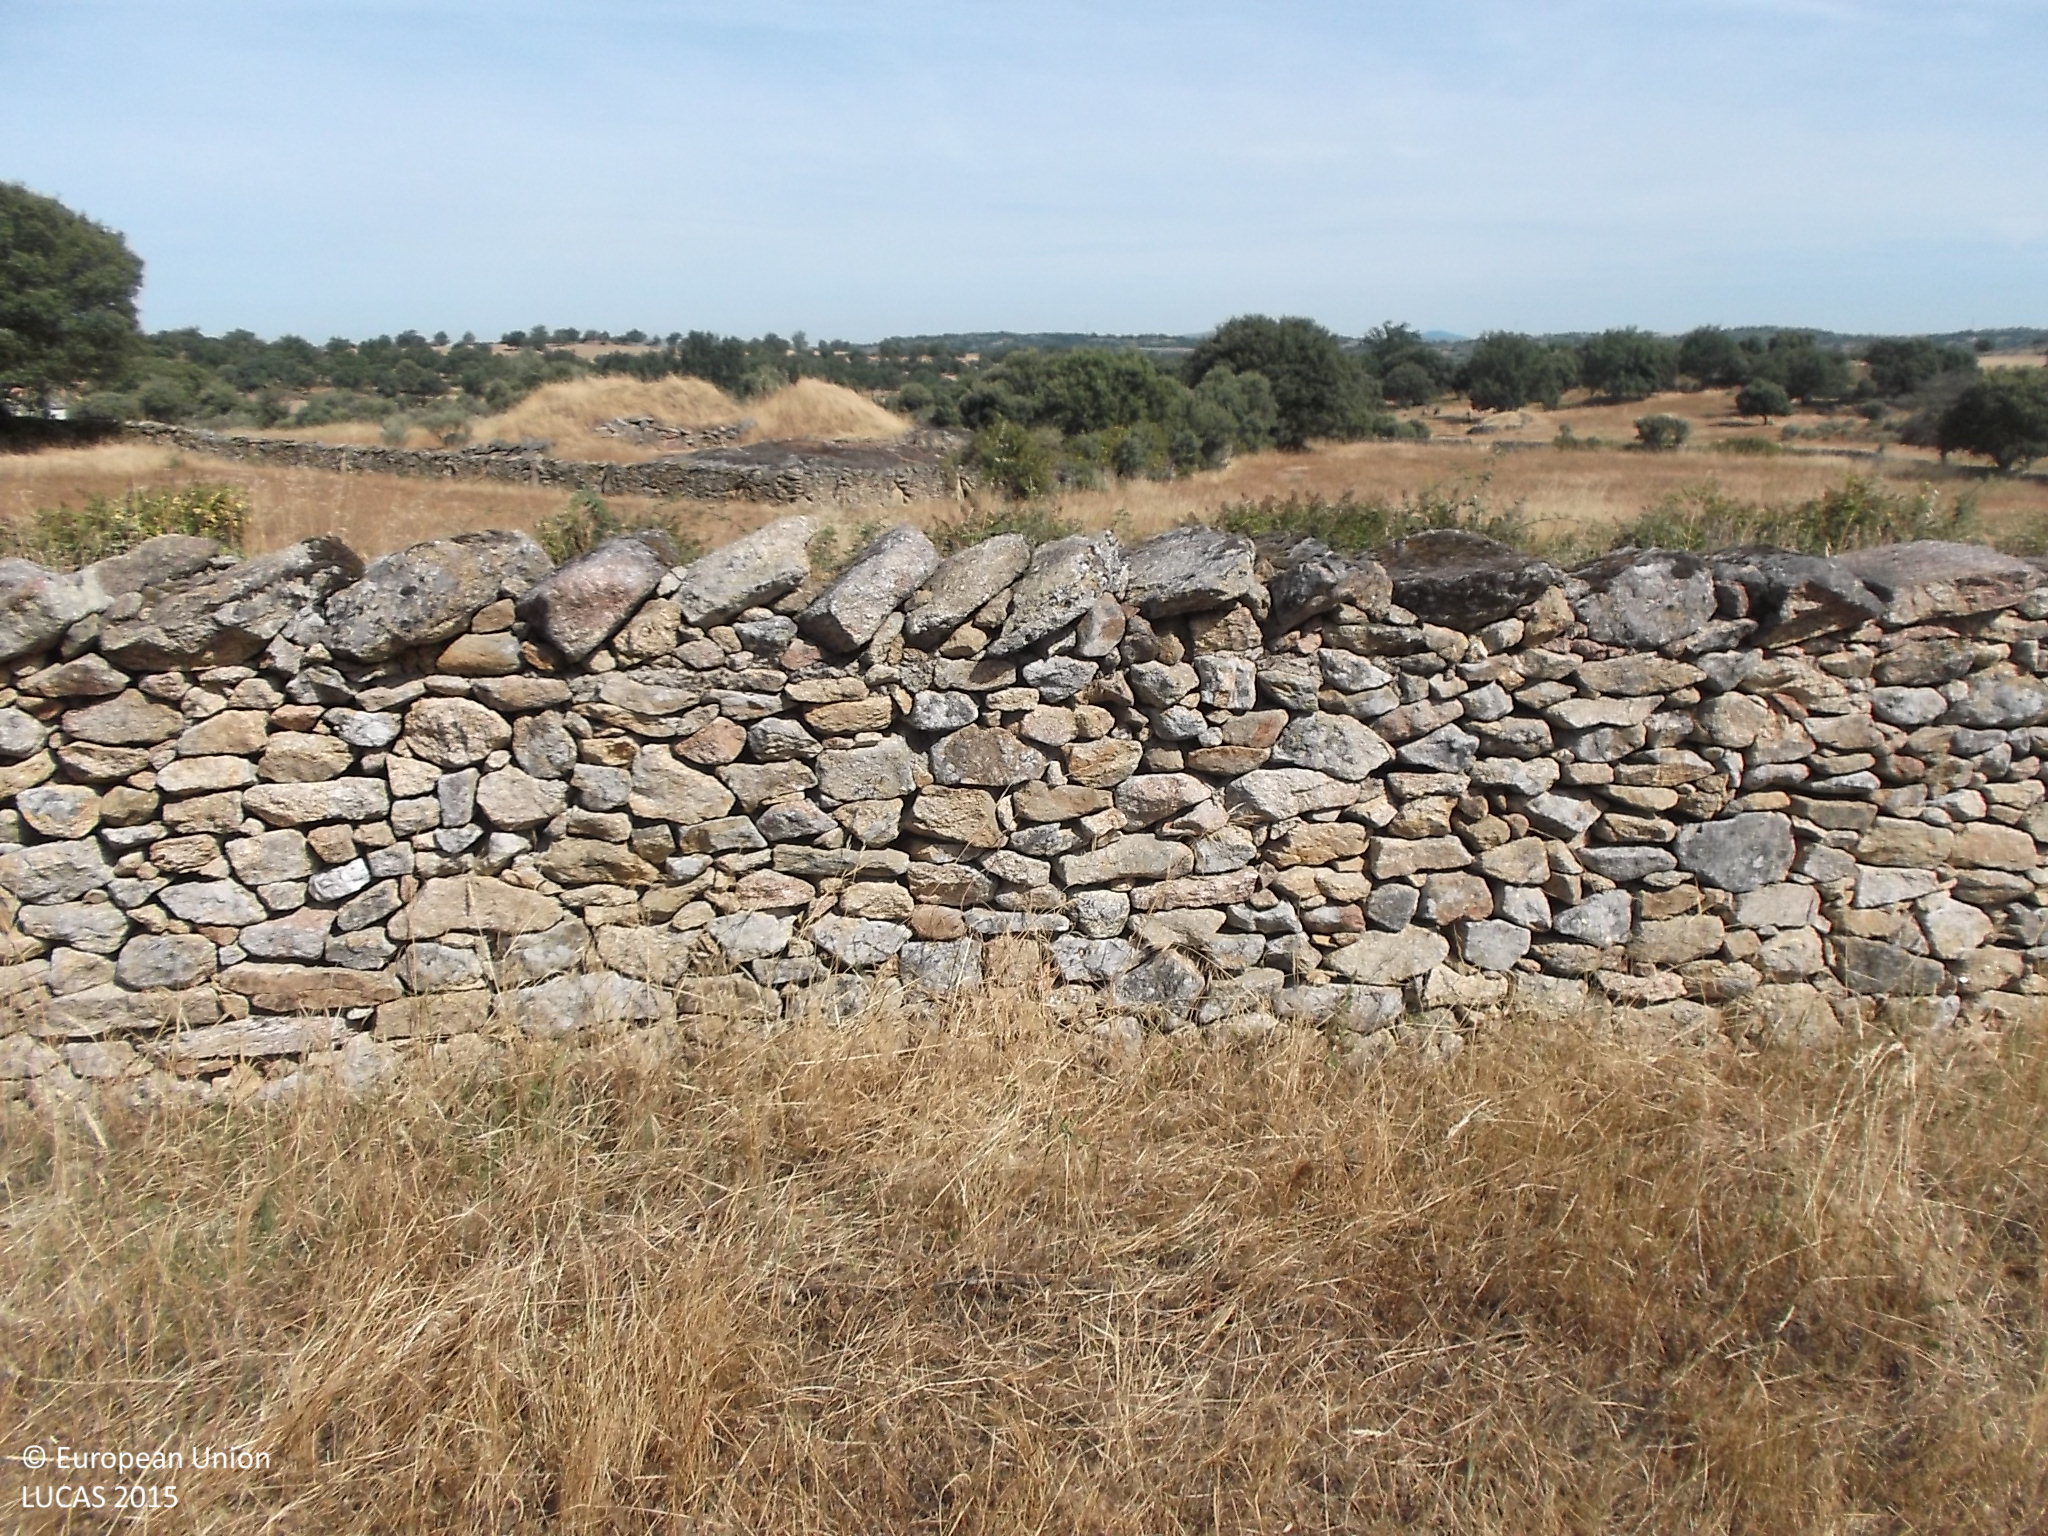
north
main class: Grassland
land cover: Grassland with sparse tree/shrub cover
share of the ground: > 75 %
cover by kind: herbaceous plants 90 %, broadleaved forest trees 5 %, shrubs 5 %
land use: Agriculture (excluding fallow land and kitchen gardens)
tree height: < 5 m
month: July
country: ES
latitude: 41.1773
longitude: -6.5127
